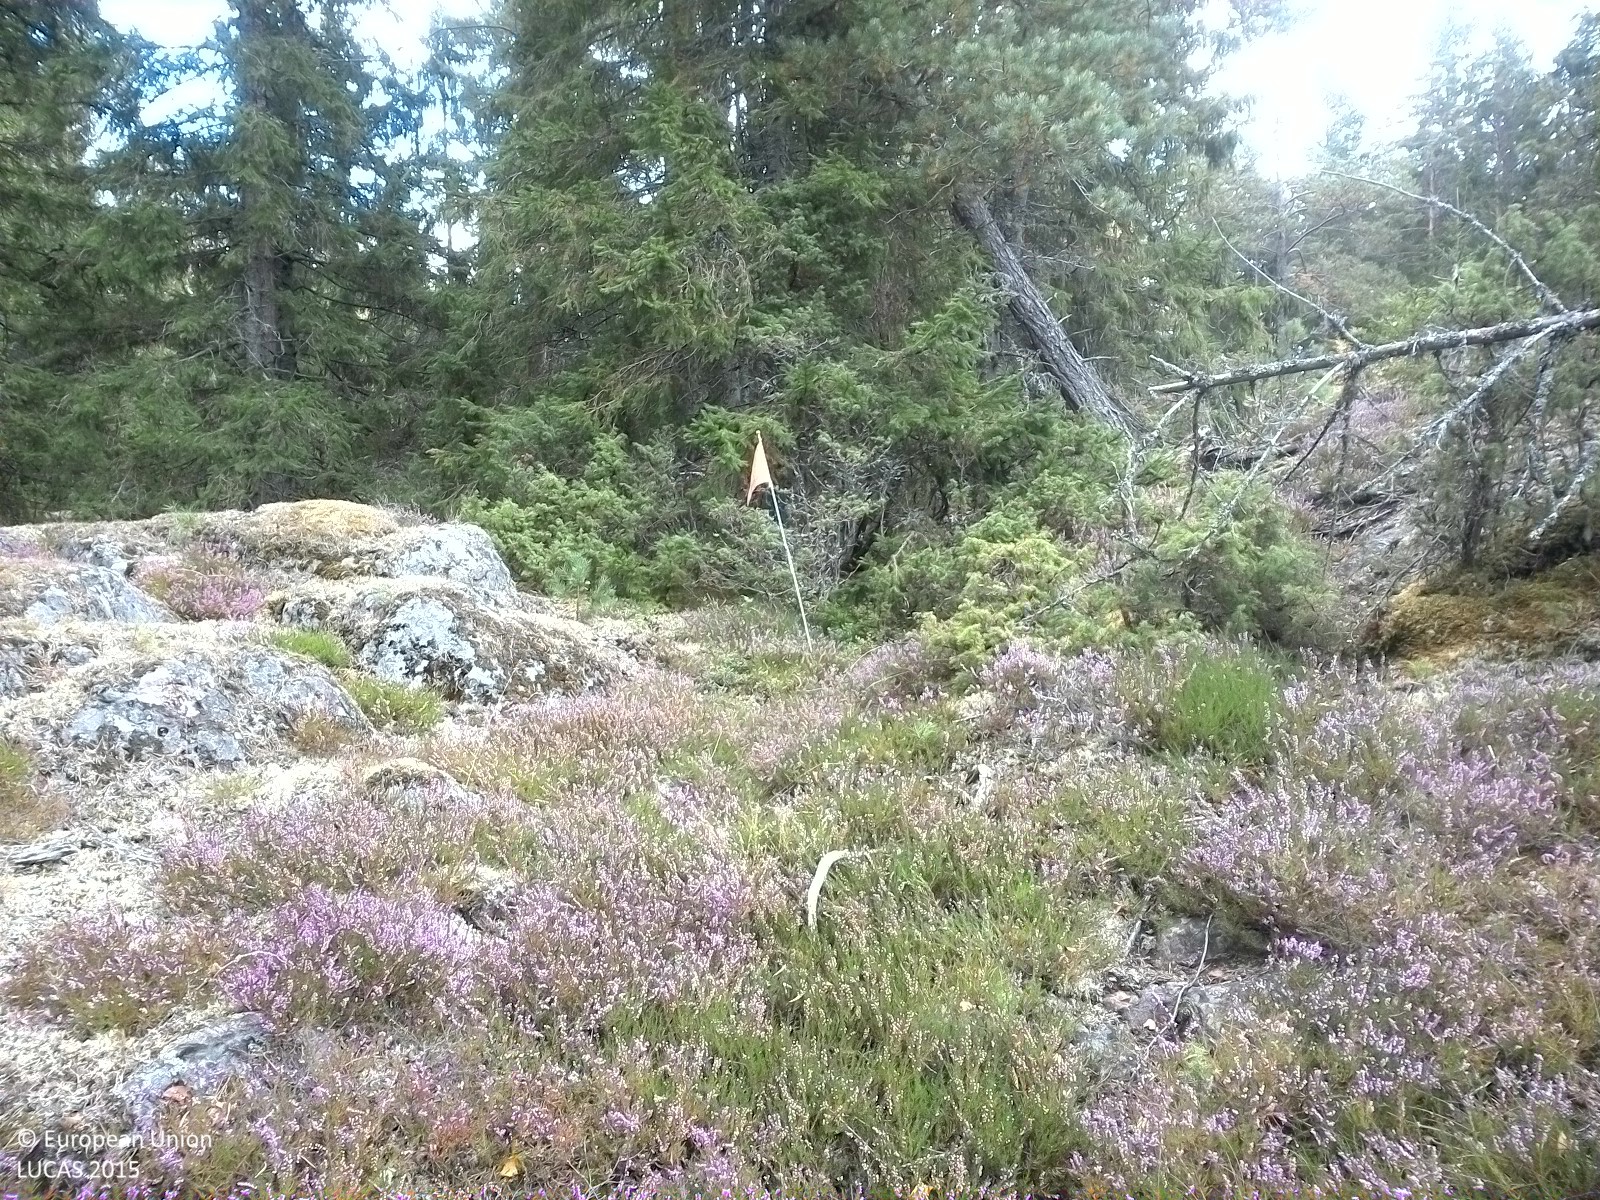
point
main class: Shrubland
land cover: Shrubland with sparse tree cover
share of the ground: 50 - 75 %
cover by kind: shrubs 55 %, lichens and mosses 20 %, coniferous forest trees 5 %
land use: Semi-natural and natural areas not in use
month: August
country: SE
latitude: 59.0070
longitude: 15.5468
